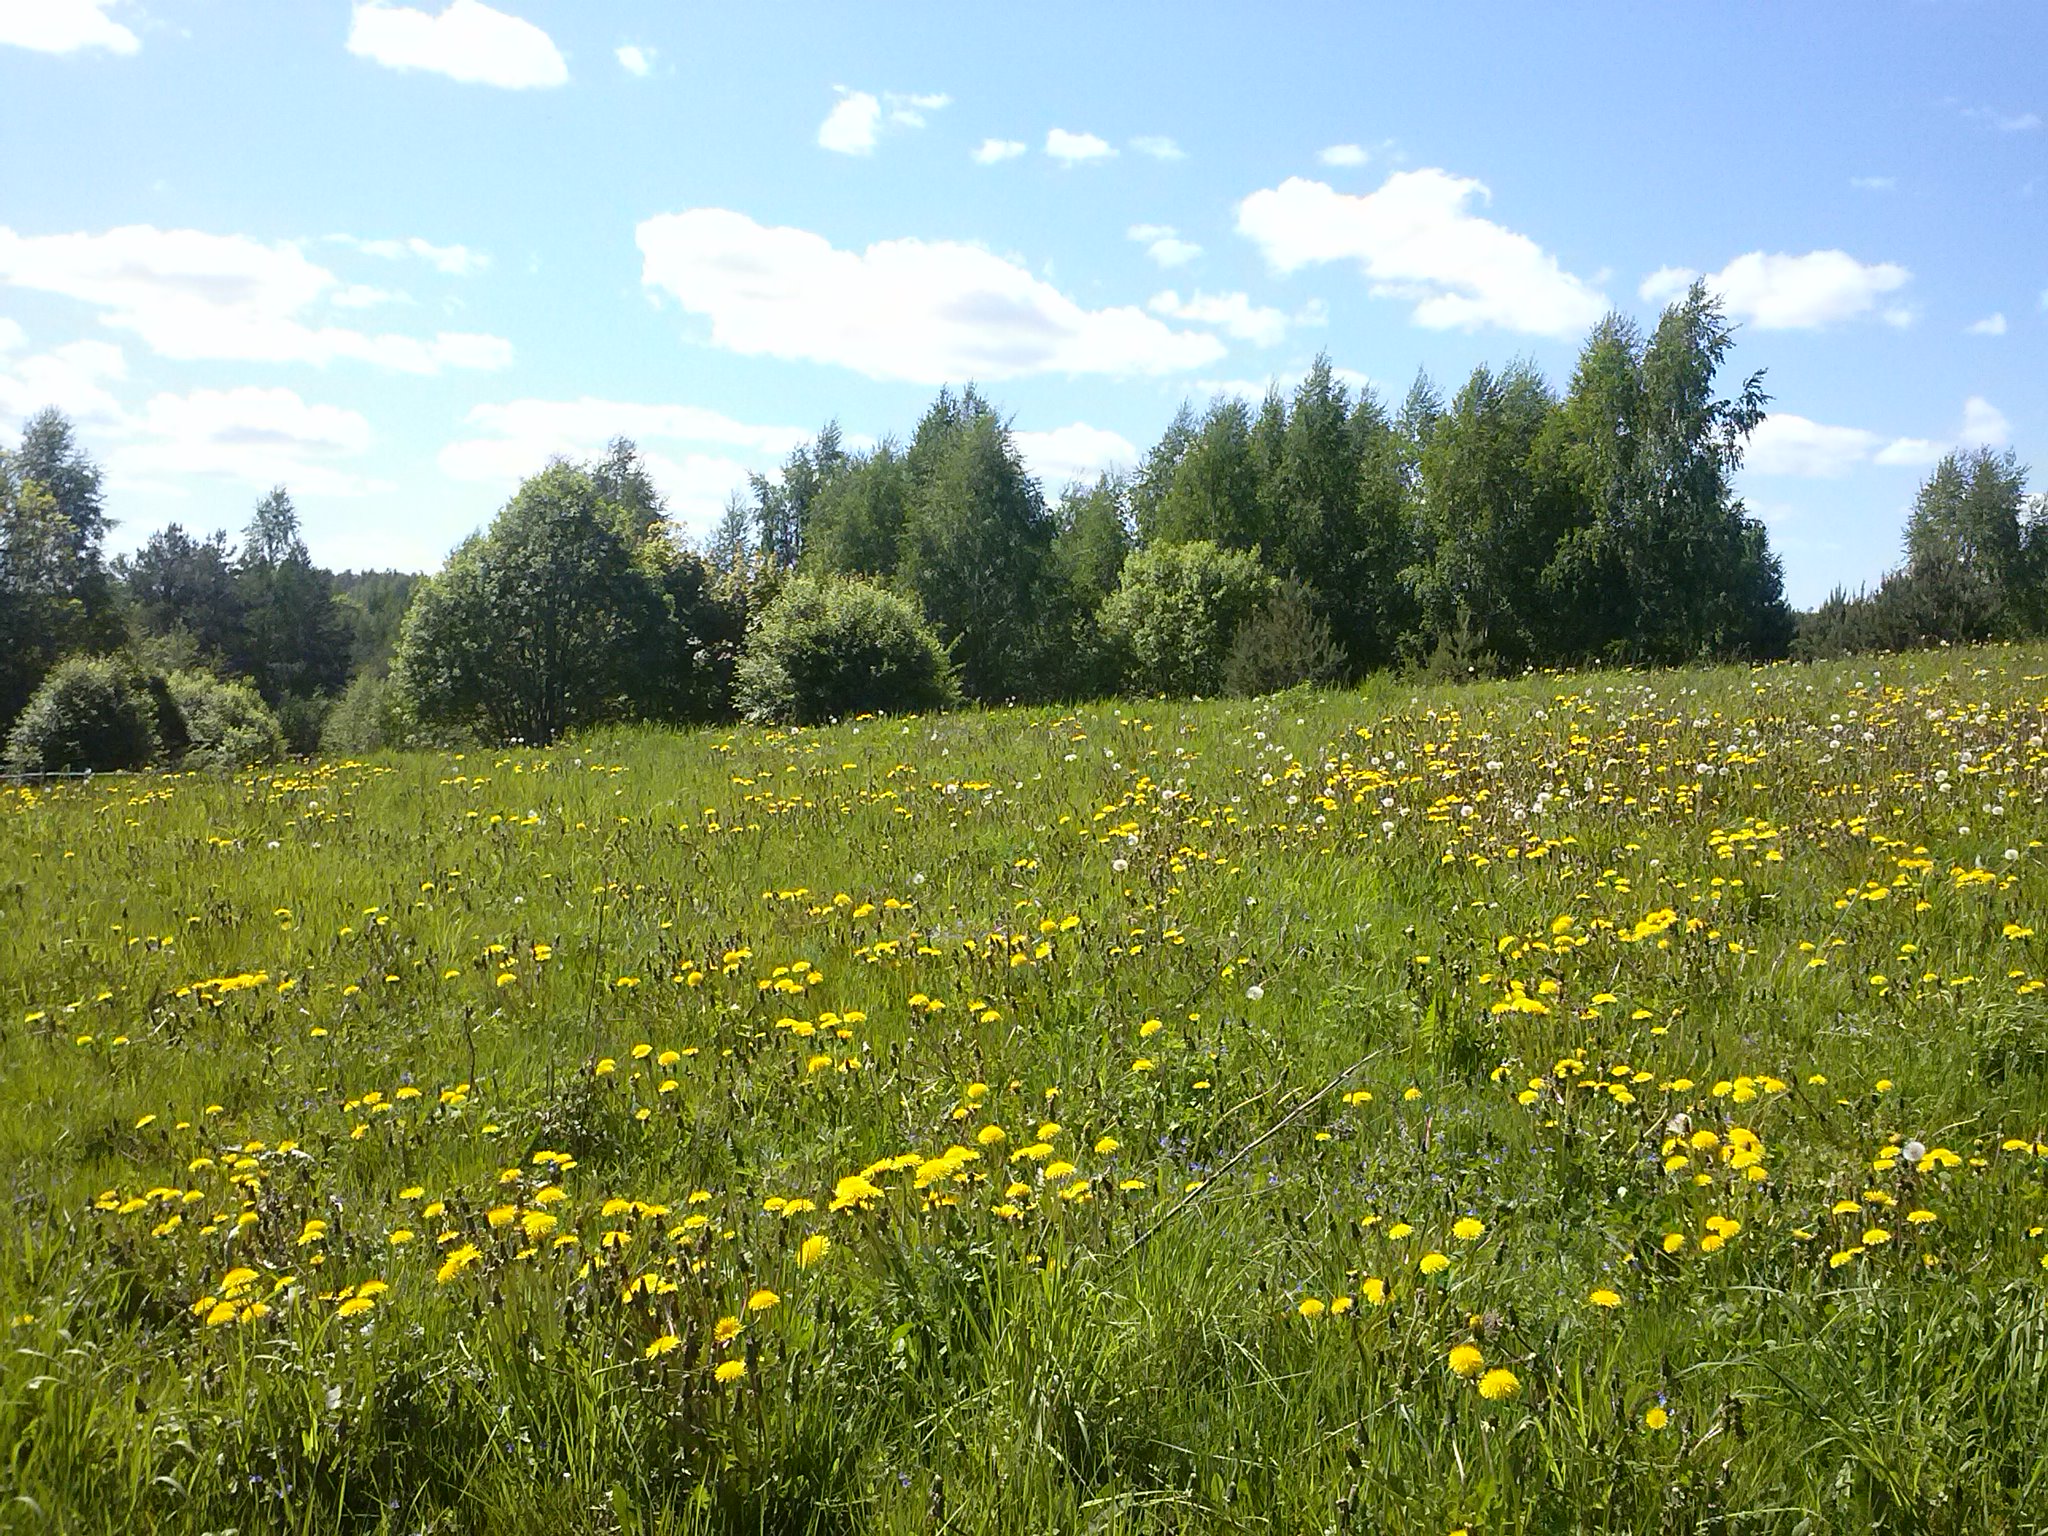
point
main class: Grassland
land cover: Grassland without tree/shrub cover
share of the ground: > 75 %
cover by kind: herbaceous plants 100 %
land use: Agriculture (excluding fallow land and kitchen gardens)
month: May
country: LV
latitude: 56.1969
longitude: 27.5733
